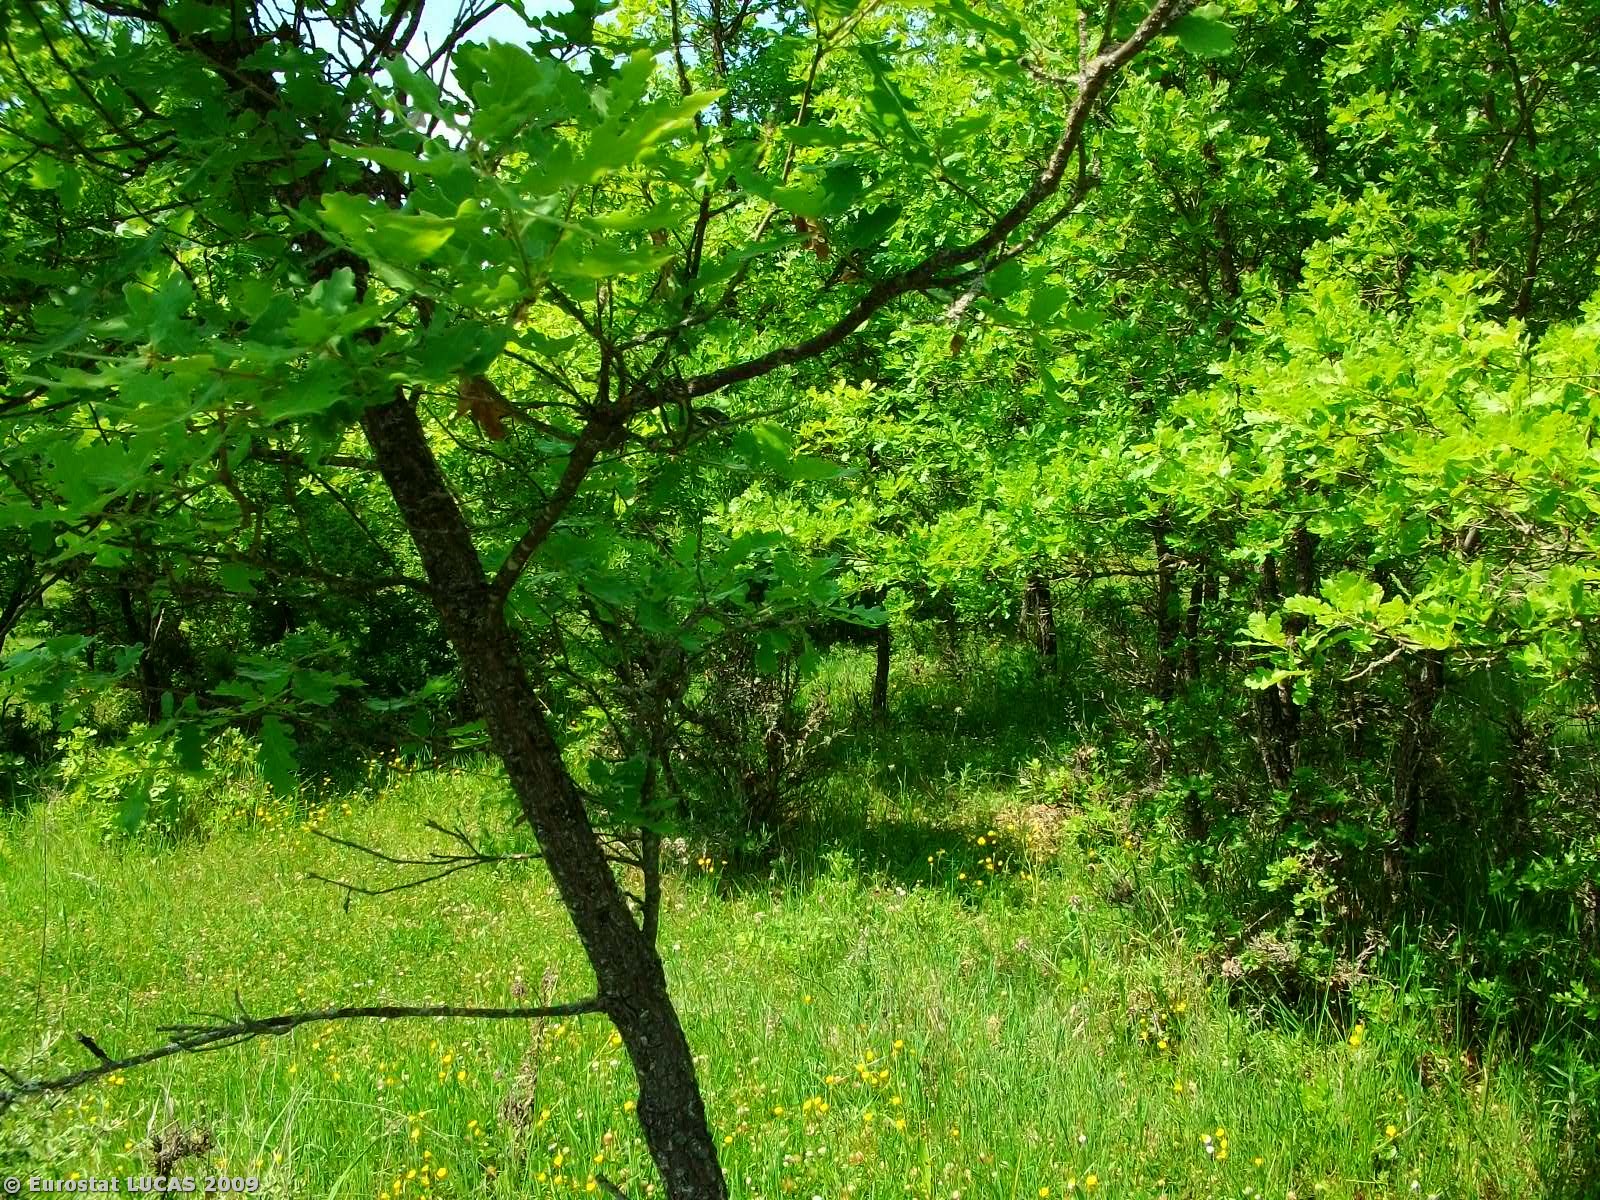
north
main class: Woodland
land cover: Broadleaved woodland
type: thermophilous deciduous forest
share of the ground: 25 - 50 %
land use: Forestry
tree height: > 5 m
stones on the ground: < 10 %
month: May
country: GR
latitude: 39.9149
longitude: 21.6738
